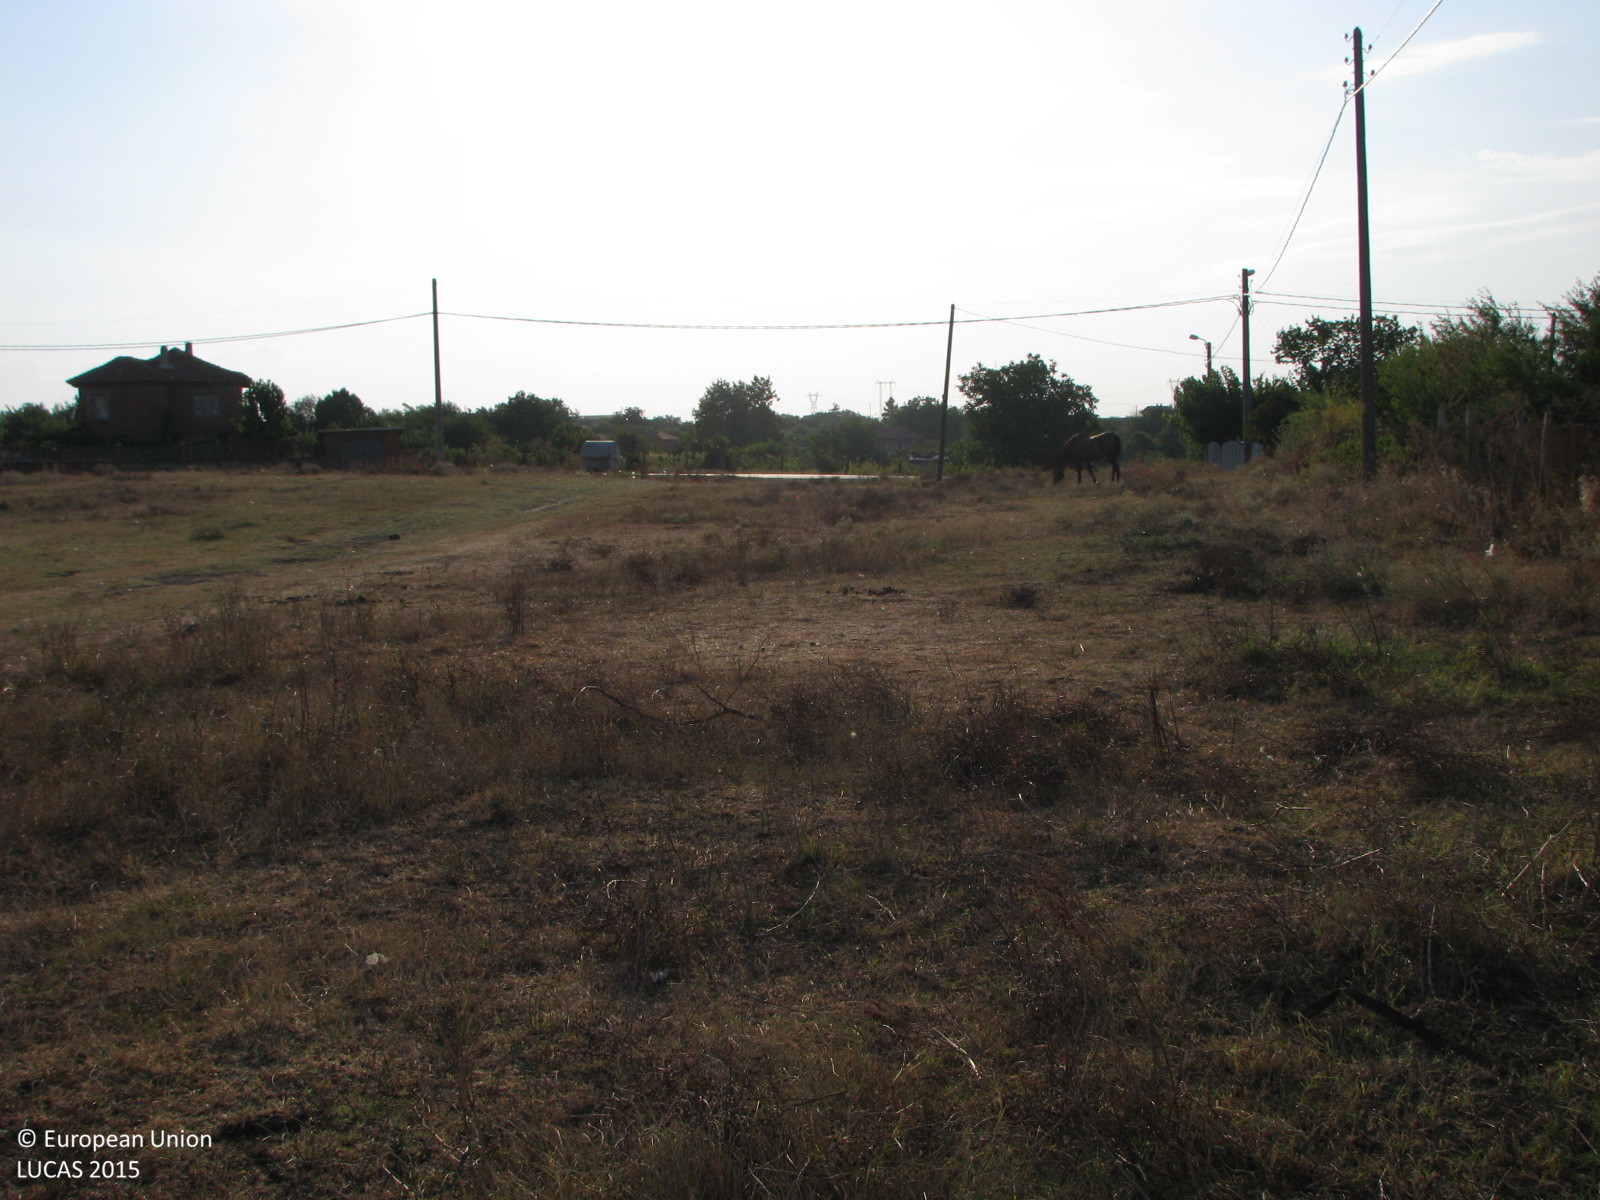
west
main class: Grassland
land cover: Grassland without tree/shrub cover
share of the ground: > 75 %
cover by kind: herbaceous plants 100 %
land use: Residential
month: August
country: BG
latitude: 42.5138
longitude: 26.6614
